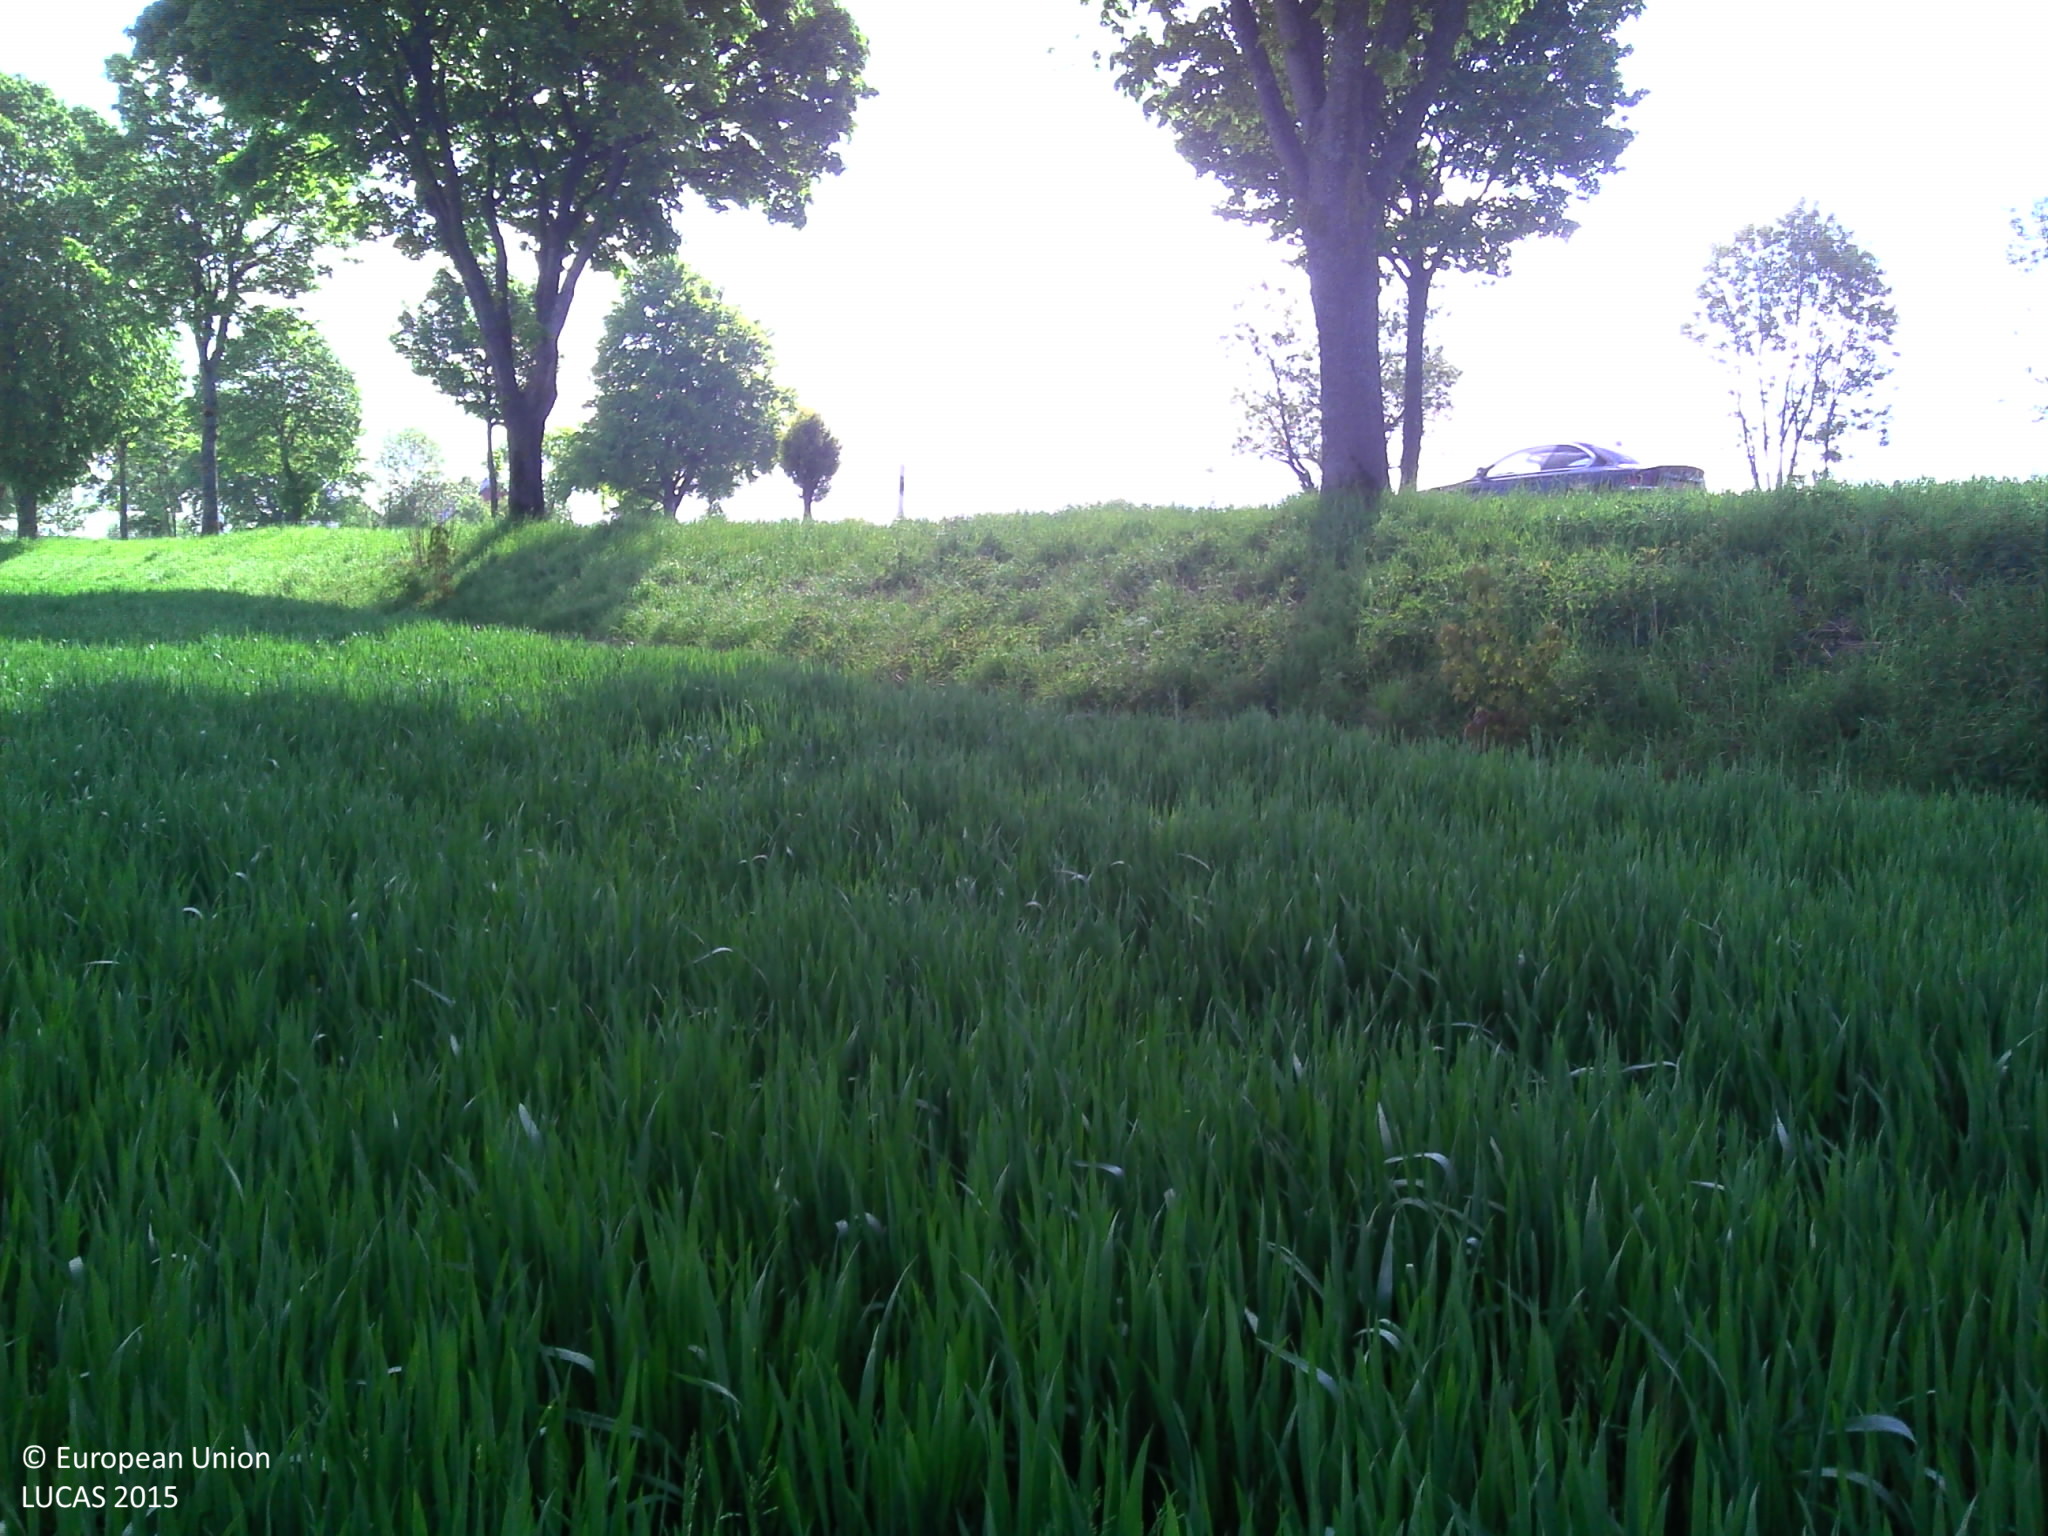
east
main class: Cropland
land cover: Common wheat
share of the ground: > 75 %
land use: Agriculture (excluding fallow land and kitchen gardens)
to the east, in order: Common wheat; Grassland without tree/shrub cover; Lines of trees; Paved roads, cycling and walking lanes; Lines of trees; Fences; Other leguminous and mixtures for fodder; Managed hedges; Grass margins; Paved roads, cycling and walking lanes; Lines of trees; Common wheat
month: May
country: LU
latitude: 50.1325
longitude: 6.0120
